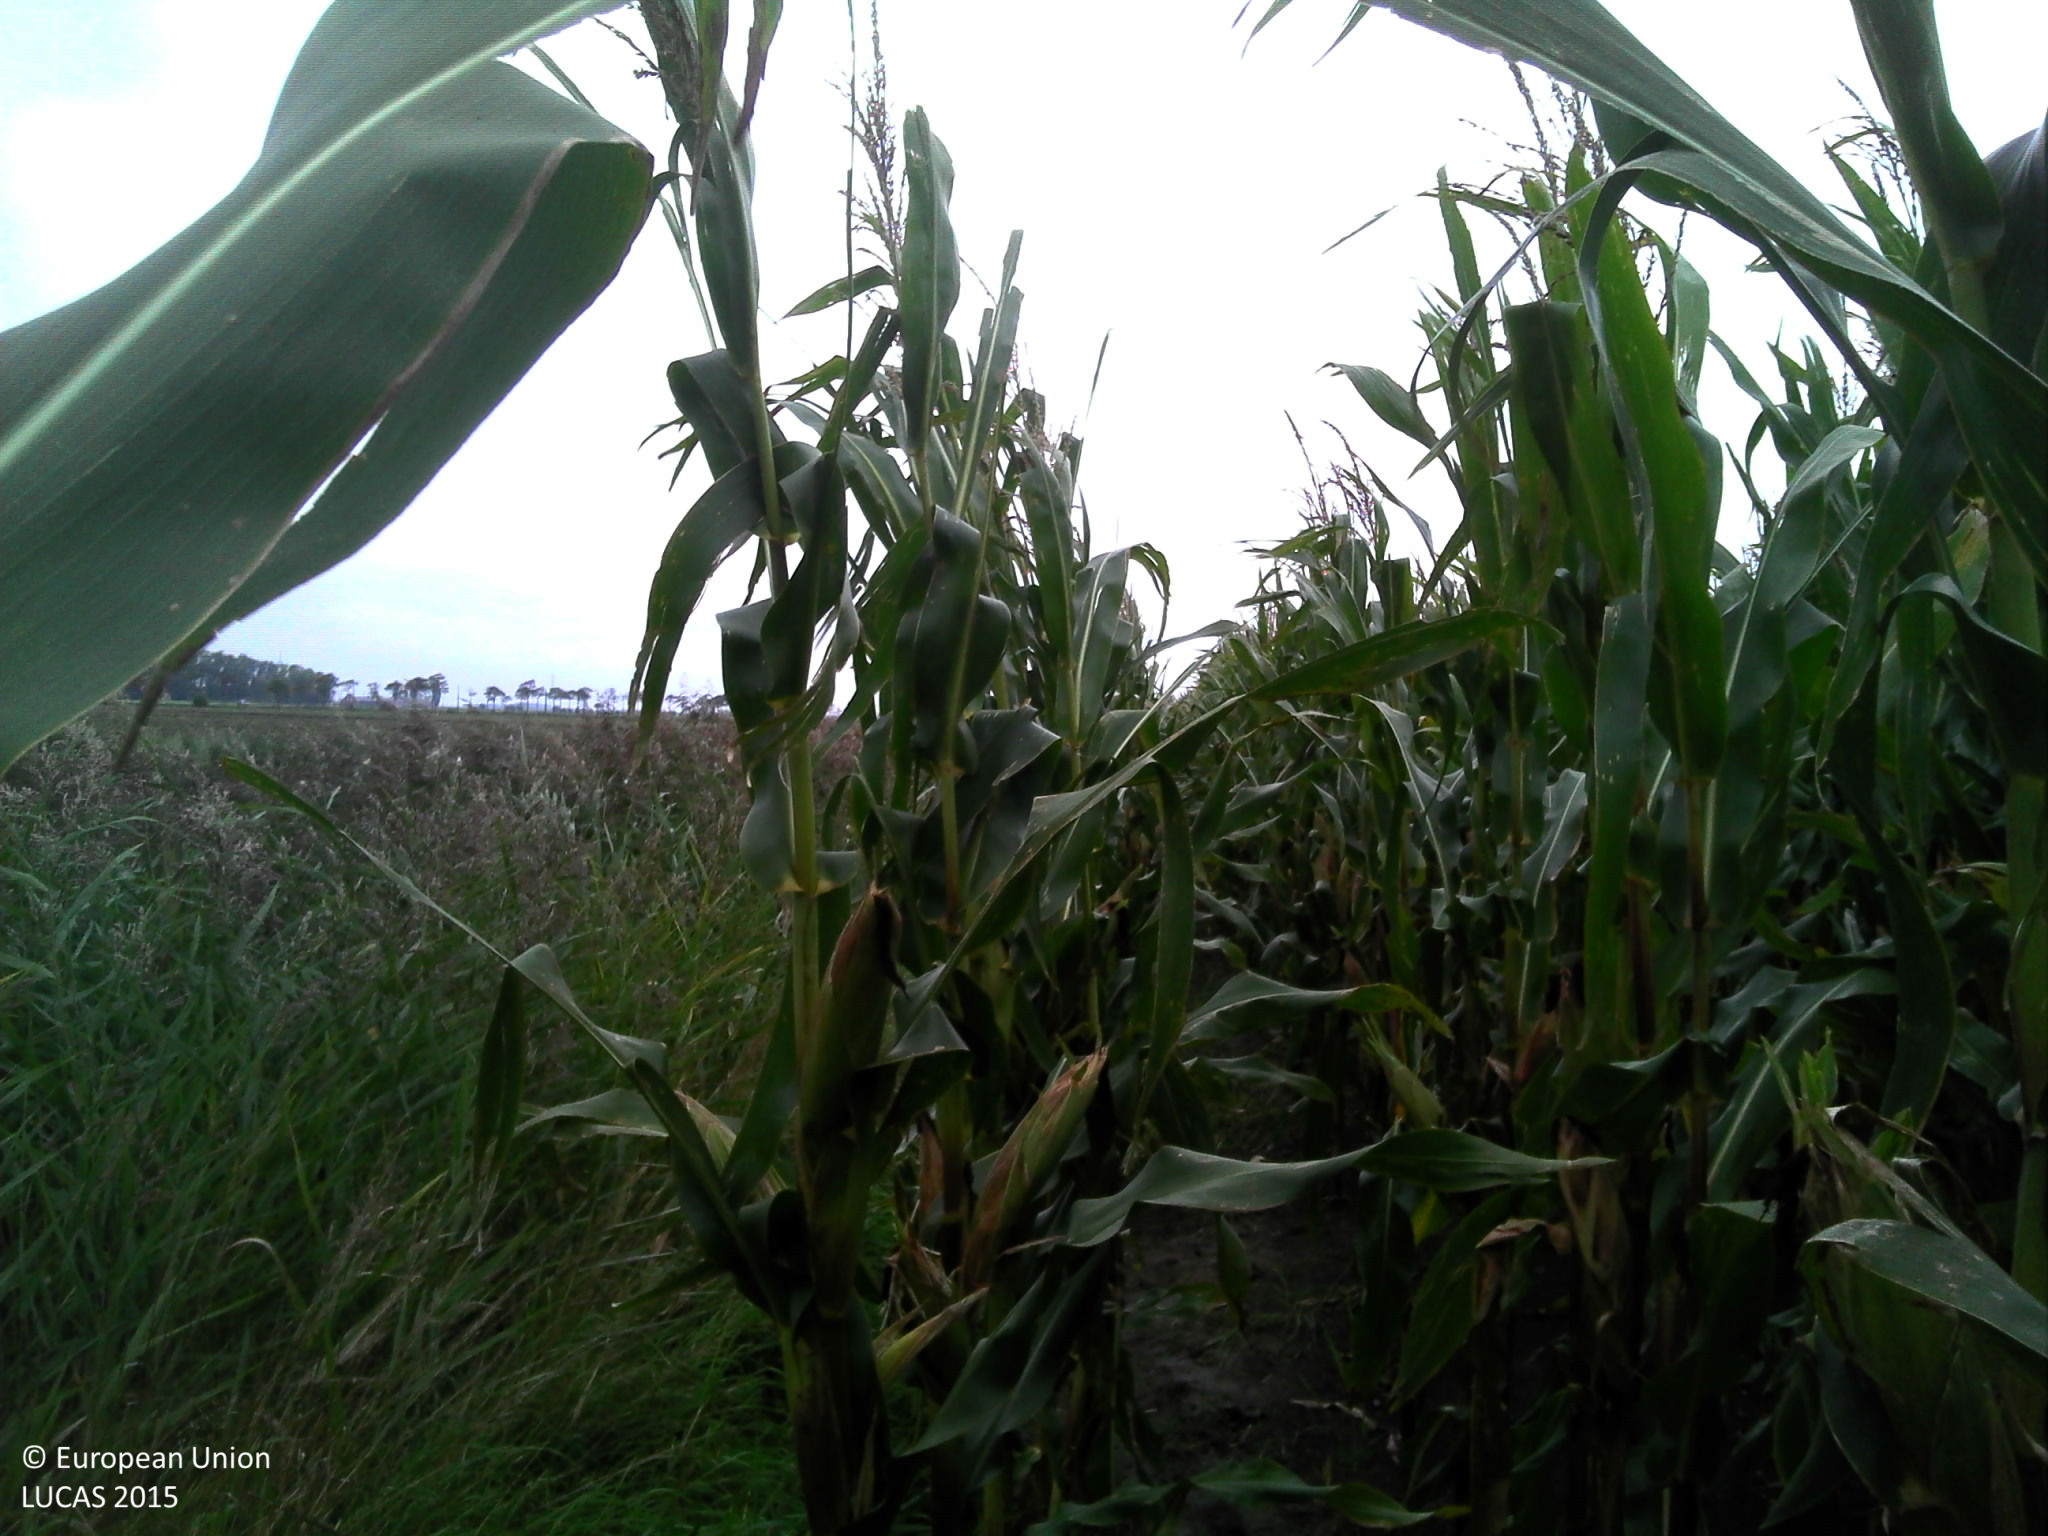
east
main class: Cropland
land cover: Maize
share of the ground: > 75 %
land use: Agriculture (excluding fallow land and kitchen gardens)
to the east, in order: Maize; Grass margins; Inland fresh running water; Grass margins; Fences; Grassland without tree/shrub cover
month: September
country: BE
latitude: 51.0728
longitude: 2.7526
